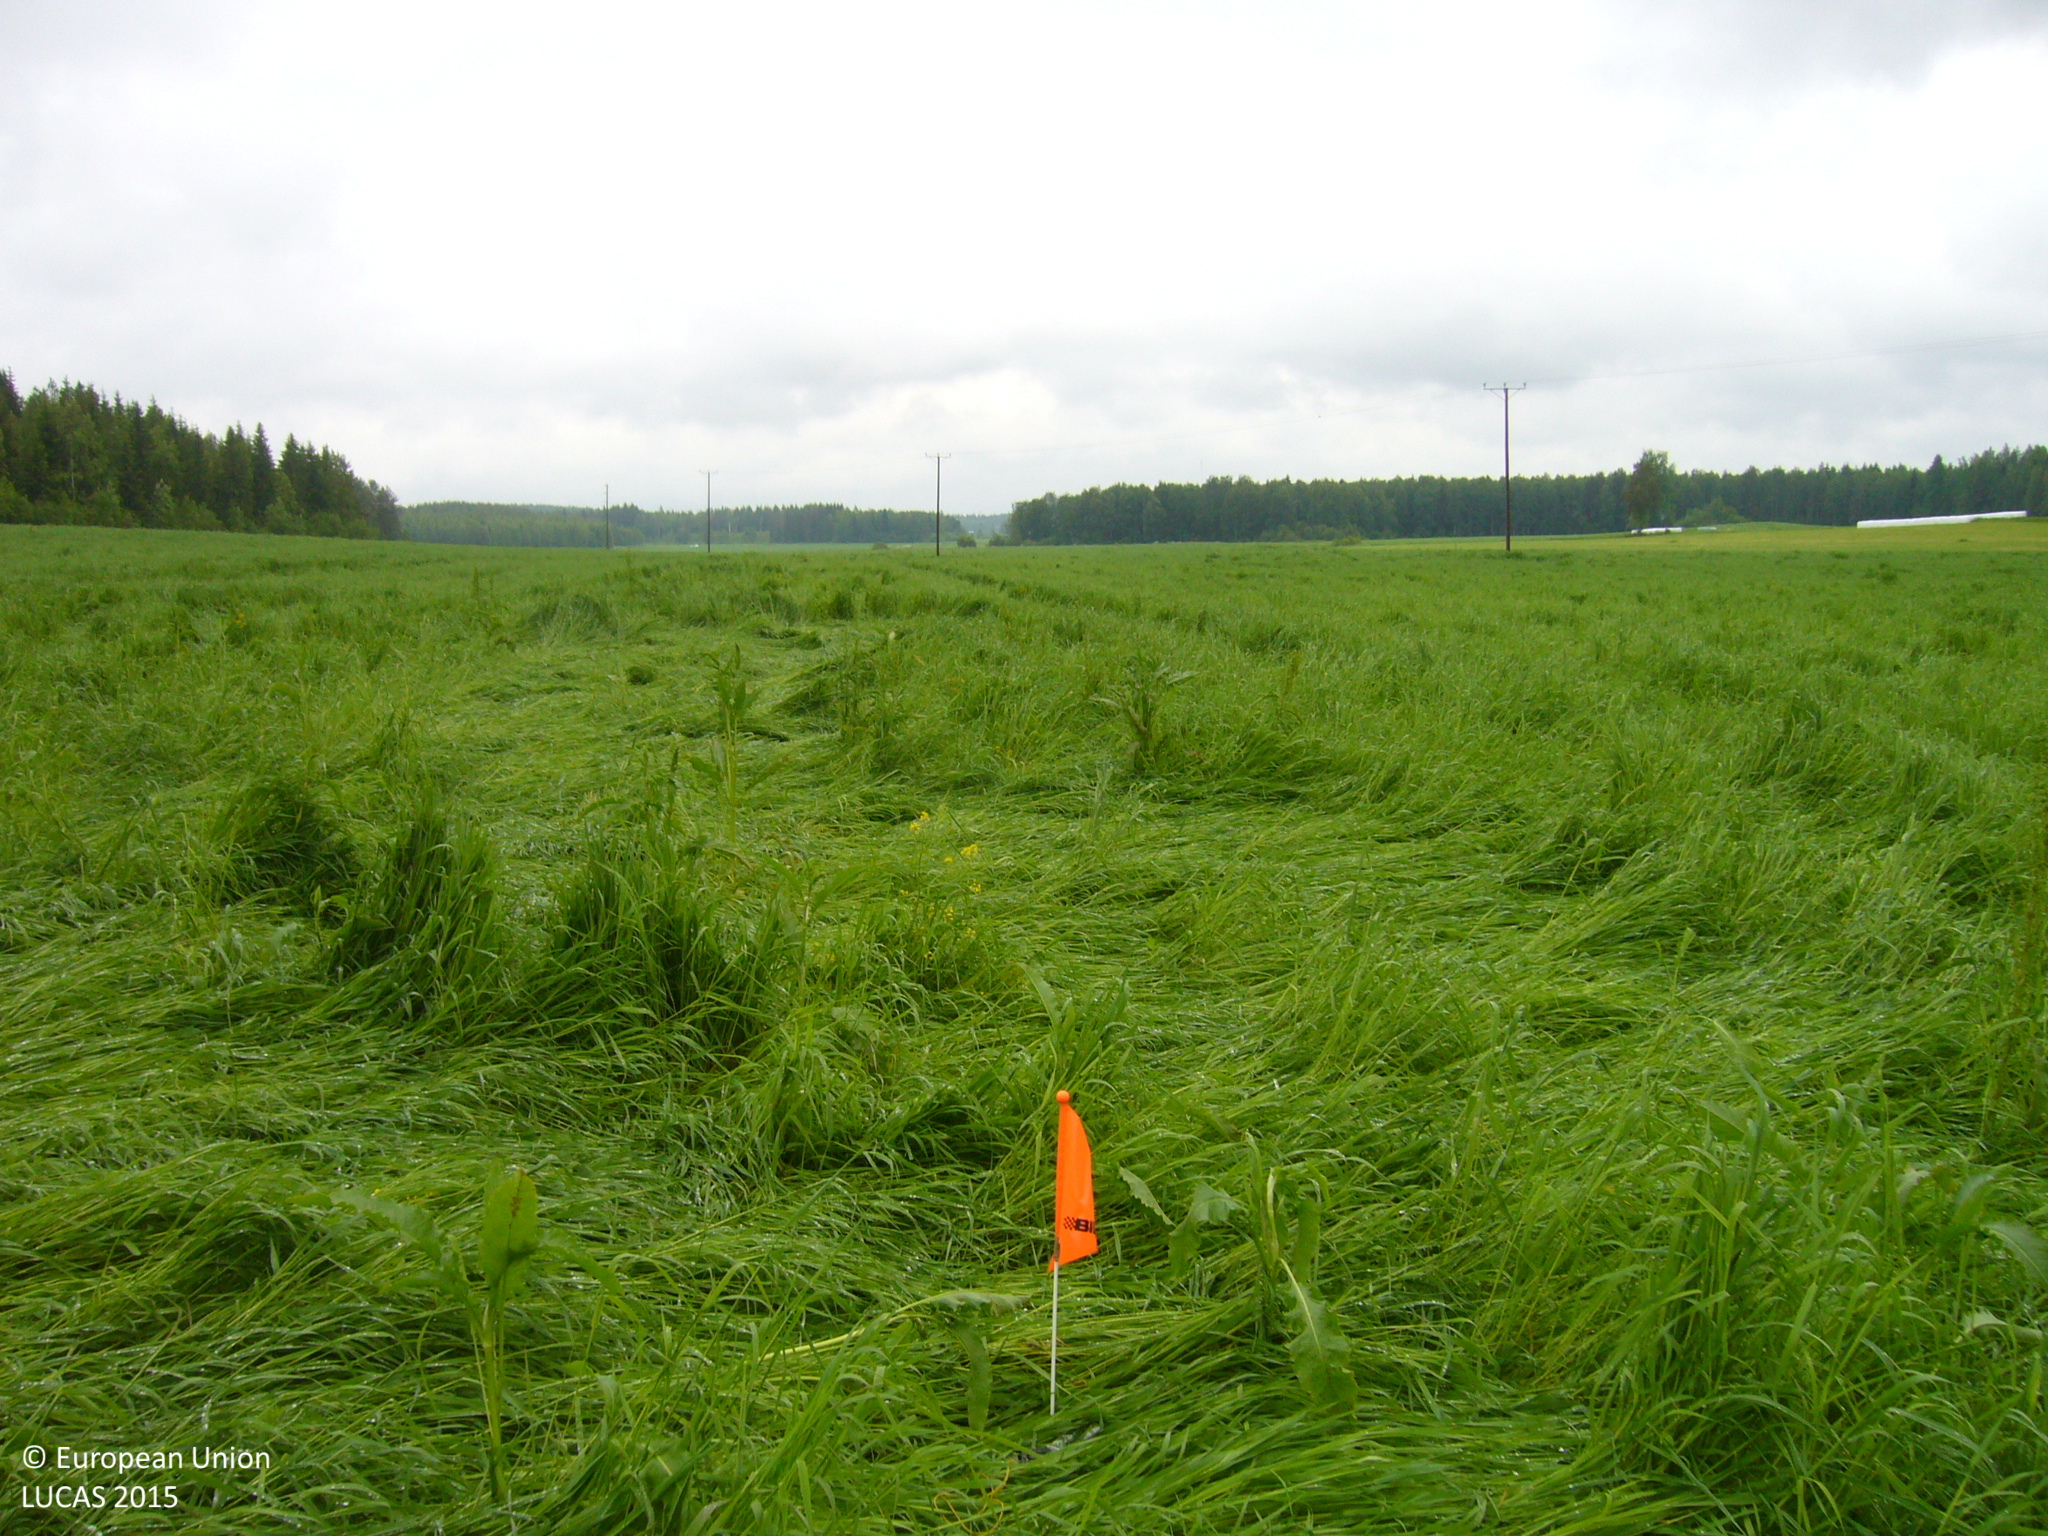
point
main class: Cropland
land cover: Temporary grasslands
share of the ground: > 75 %
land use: Agriculture (excluding fallow land and kitchen gardens)
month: June
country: FI
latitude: 63.6453
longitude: 26.4164
